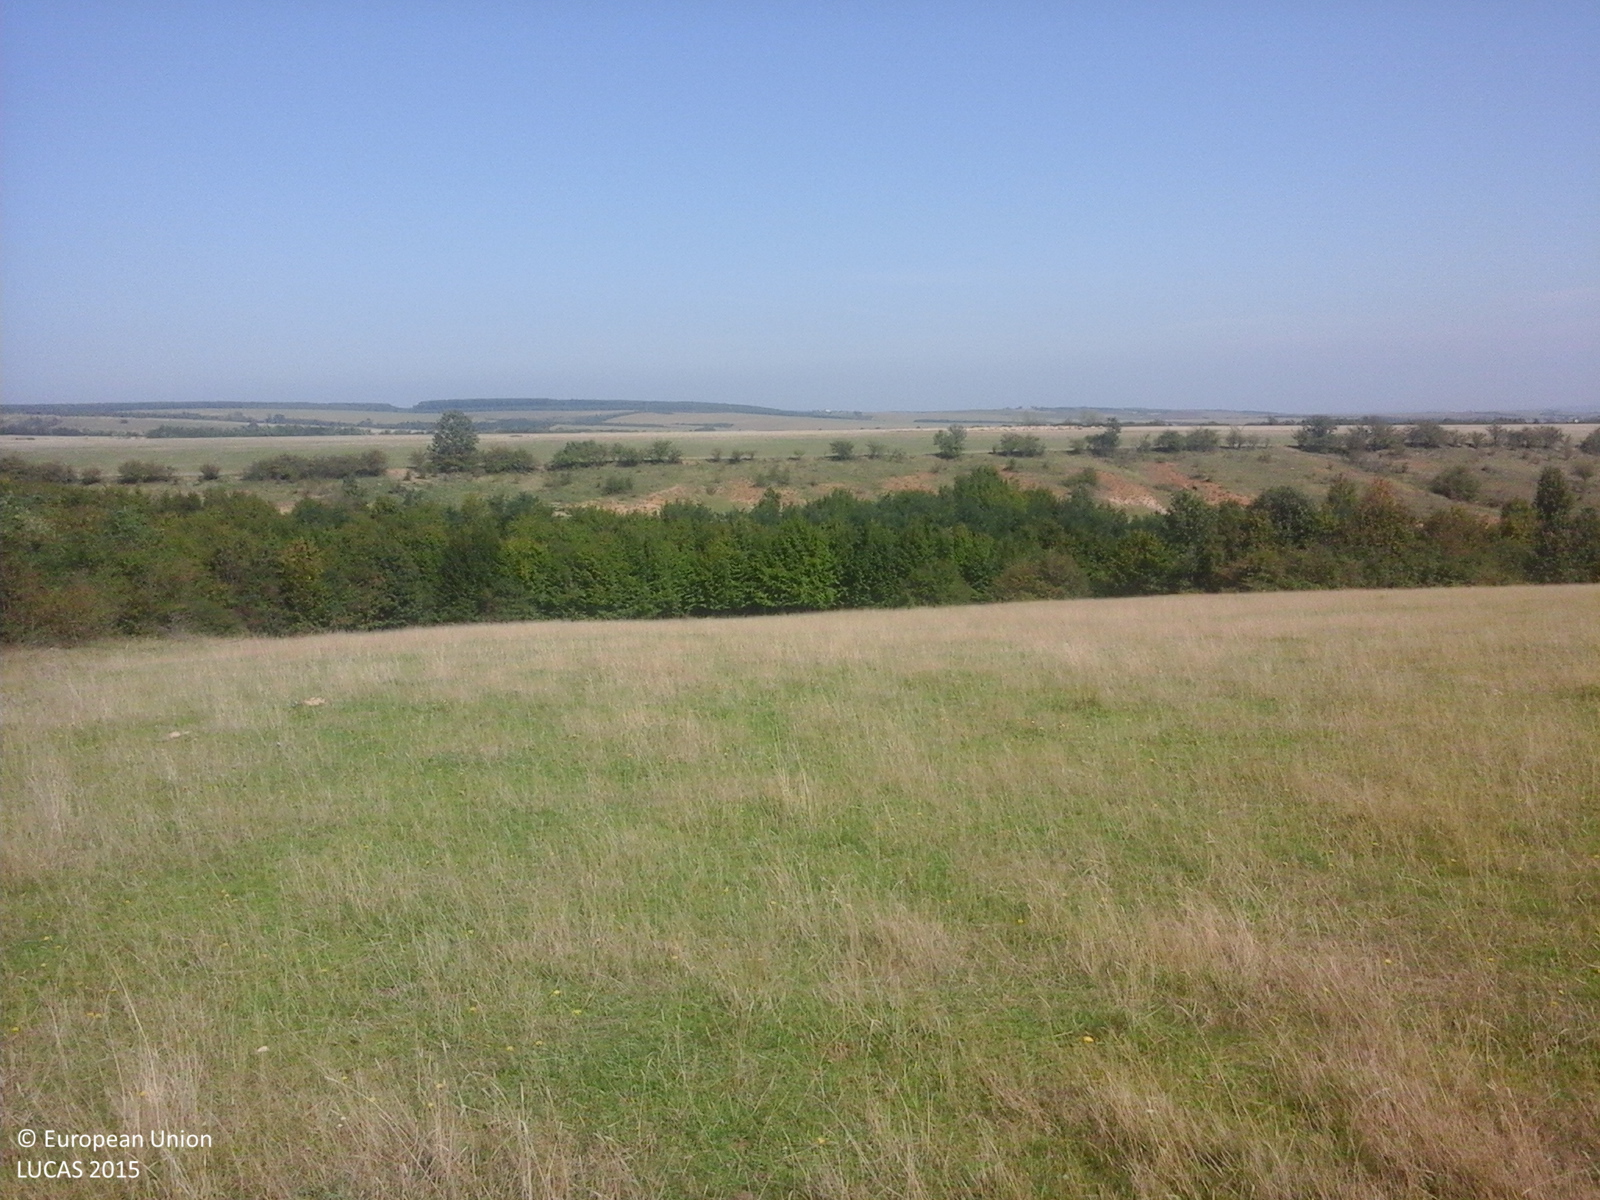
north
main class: Grassland
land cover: Grassland without tree/shrub cover
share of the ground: > 75 %
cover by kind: herbaceous plants 100 %
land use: Agriculture (excluding fallow land and kitchen gardens)
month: September
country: RO
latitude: 47.4076
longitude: 22.7425
